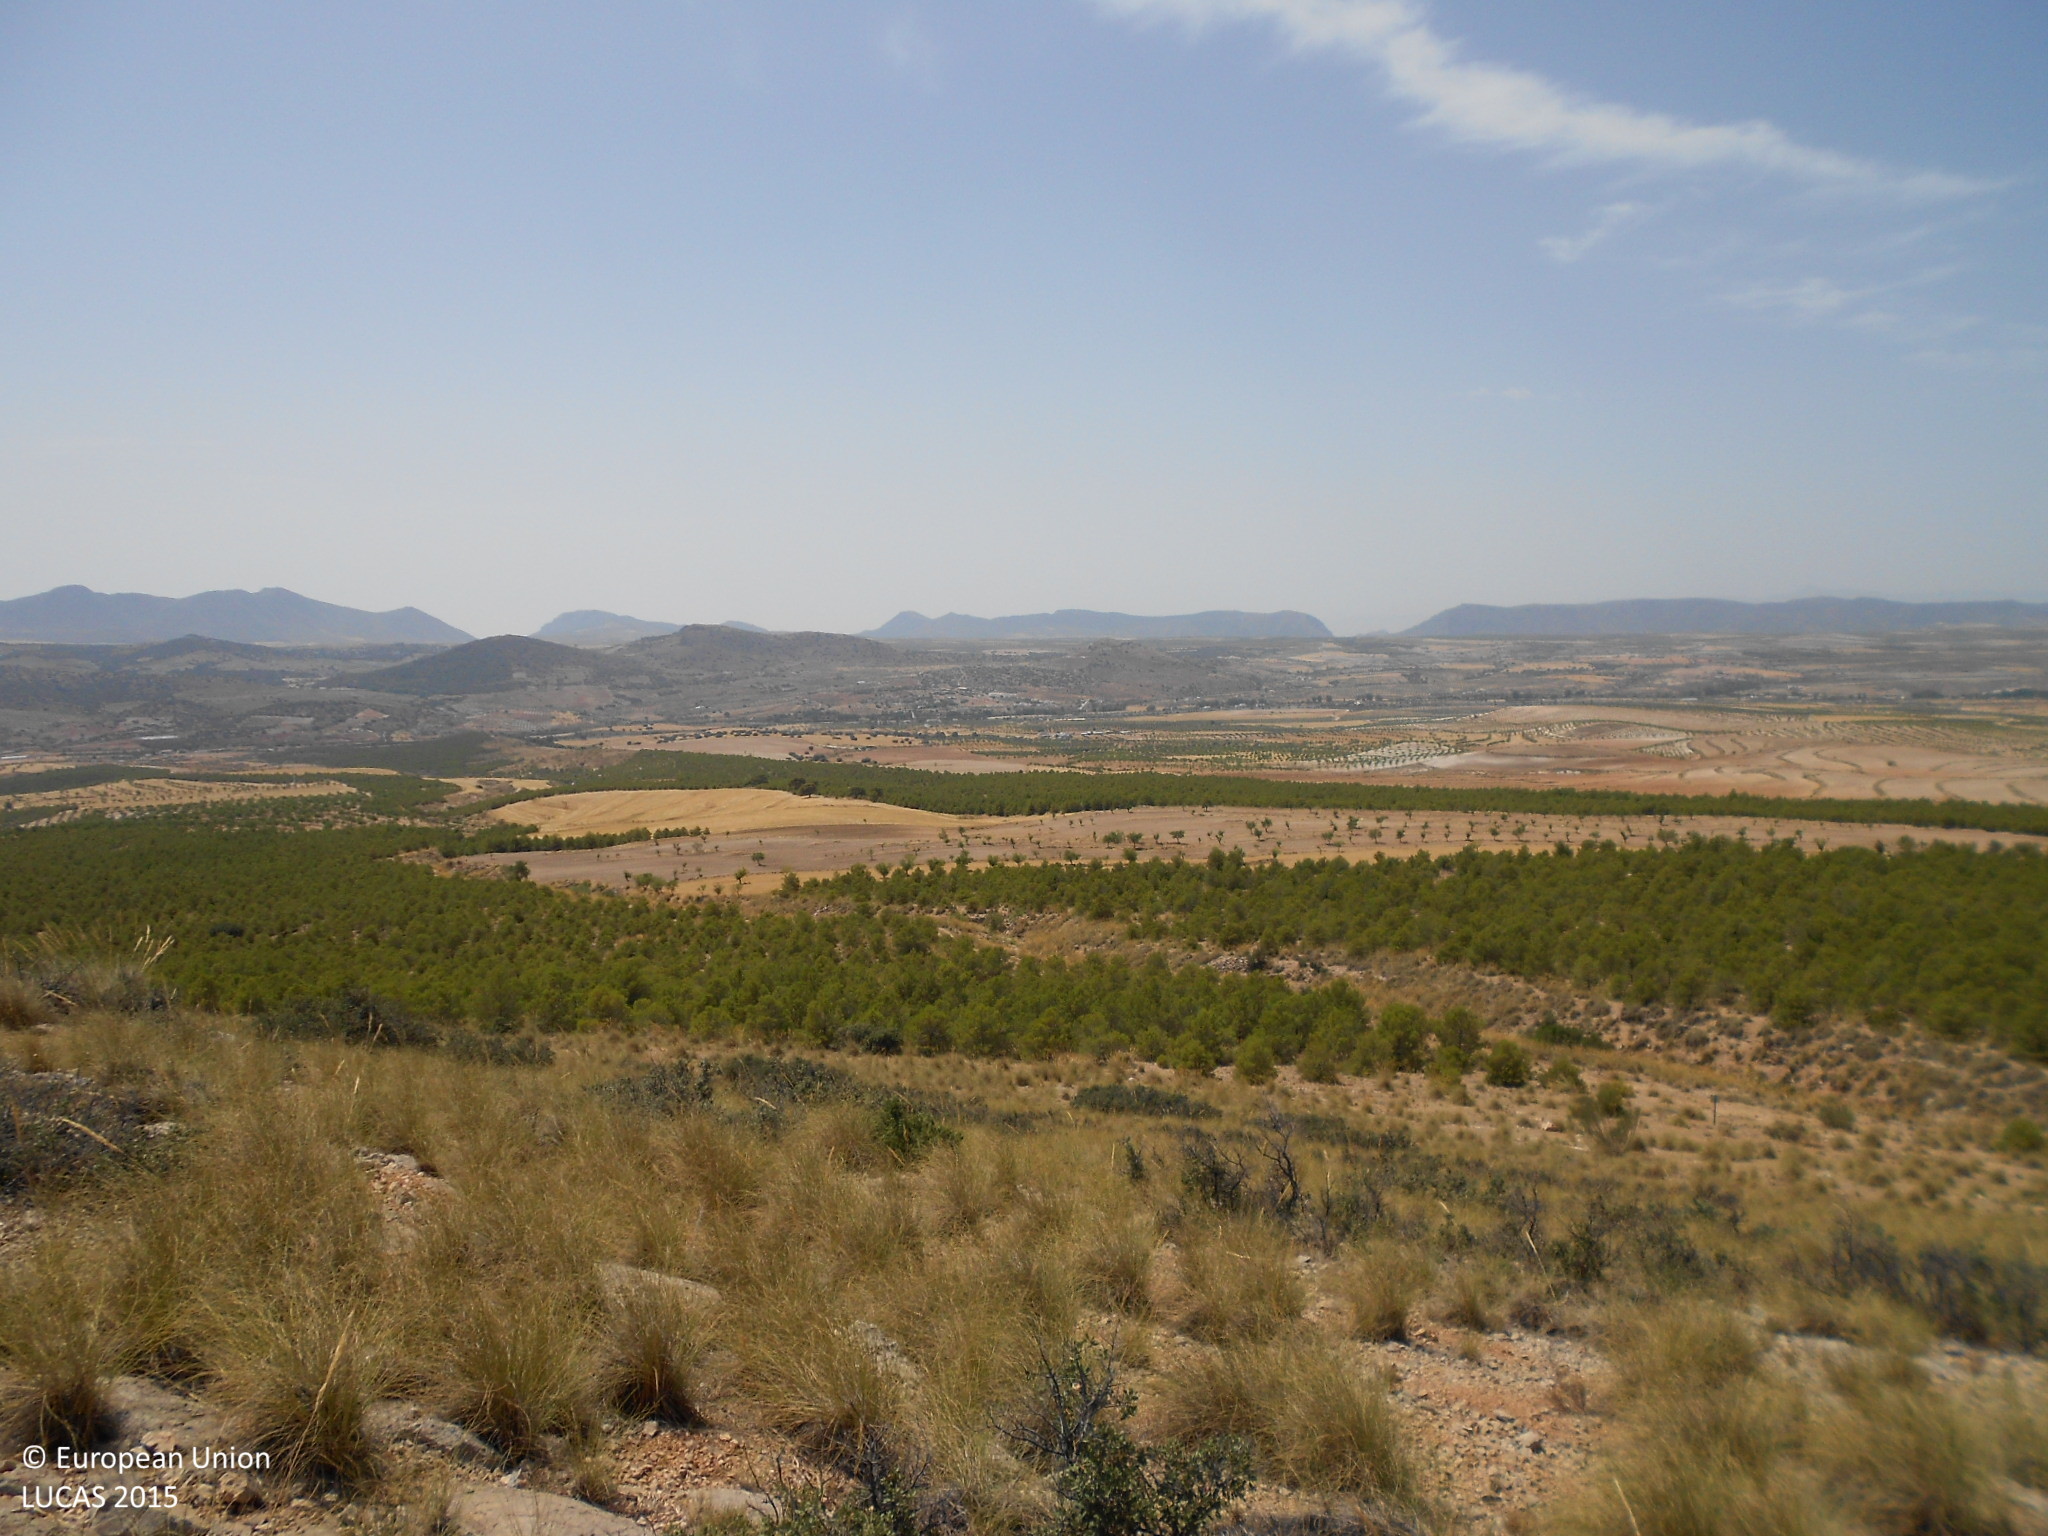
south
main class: Shrubland
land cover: Shrubland without tree cover
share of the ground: 50 - 75 %
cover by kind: shrubs 60 %, herbaceous plants 20 %, consolidated bare surface 20 %
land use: Semi-natural and natural areas not in use
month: July
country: ES
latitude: 37.6322
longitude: -2.2347
